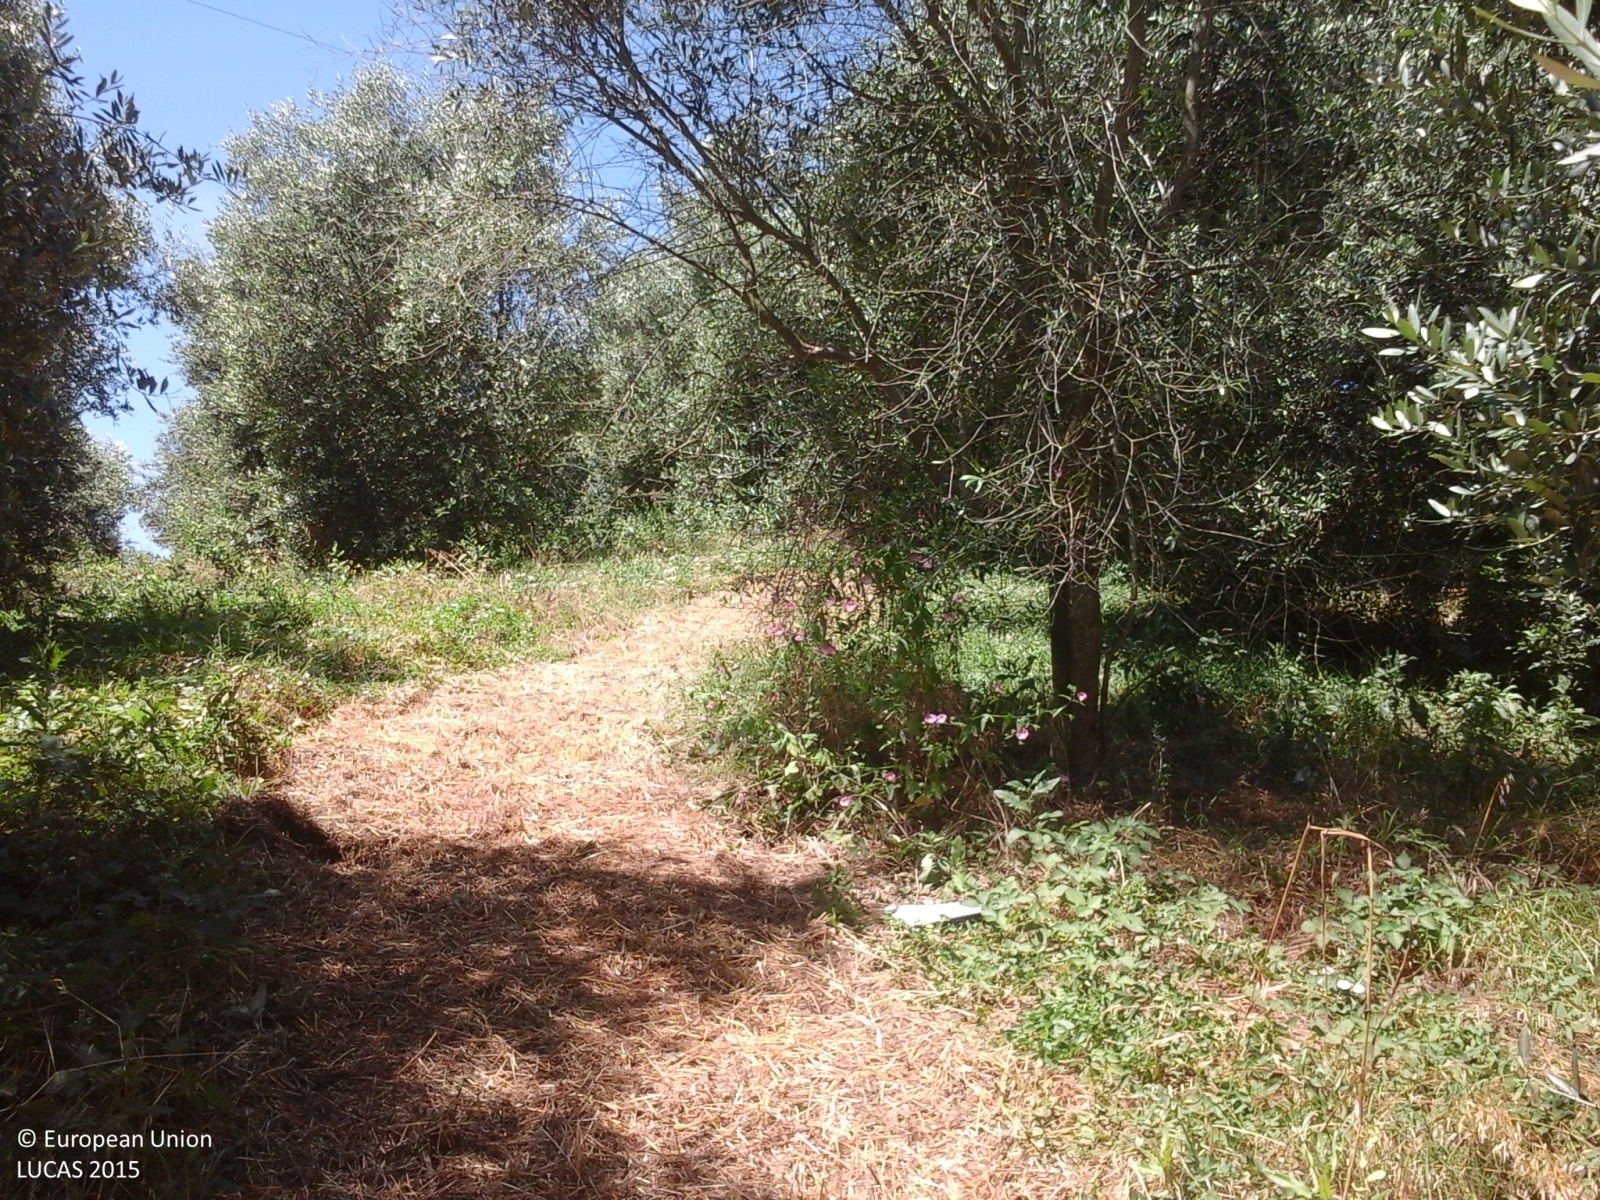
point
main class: Cropland
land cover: Olive groves
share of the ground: > 75 %
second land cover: Spontaneously vegetated surfaces
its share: > 75 %
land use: Agriculture (excluding fallow land and kitchen gardens)
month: June
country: IT
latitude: 43.5902
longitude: 10.7288
